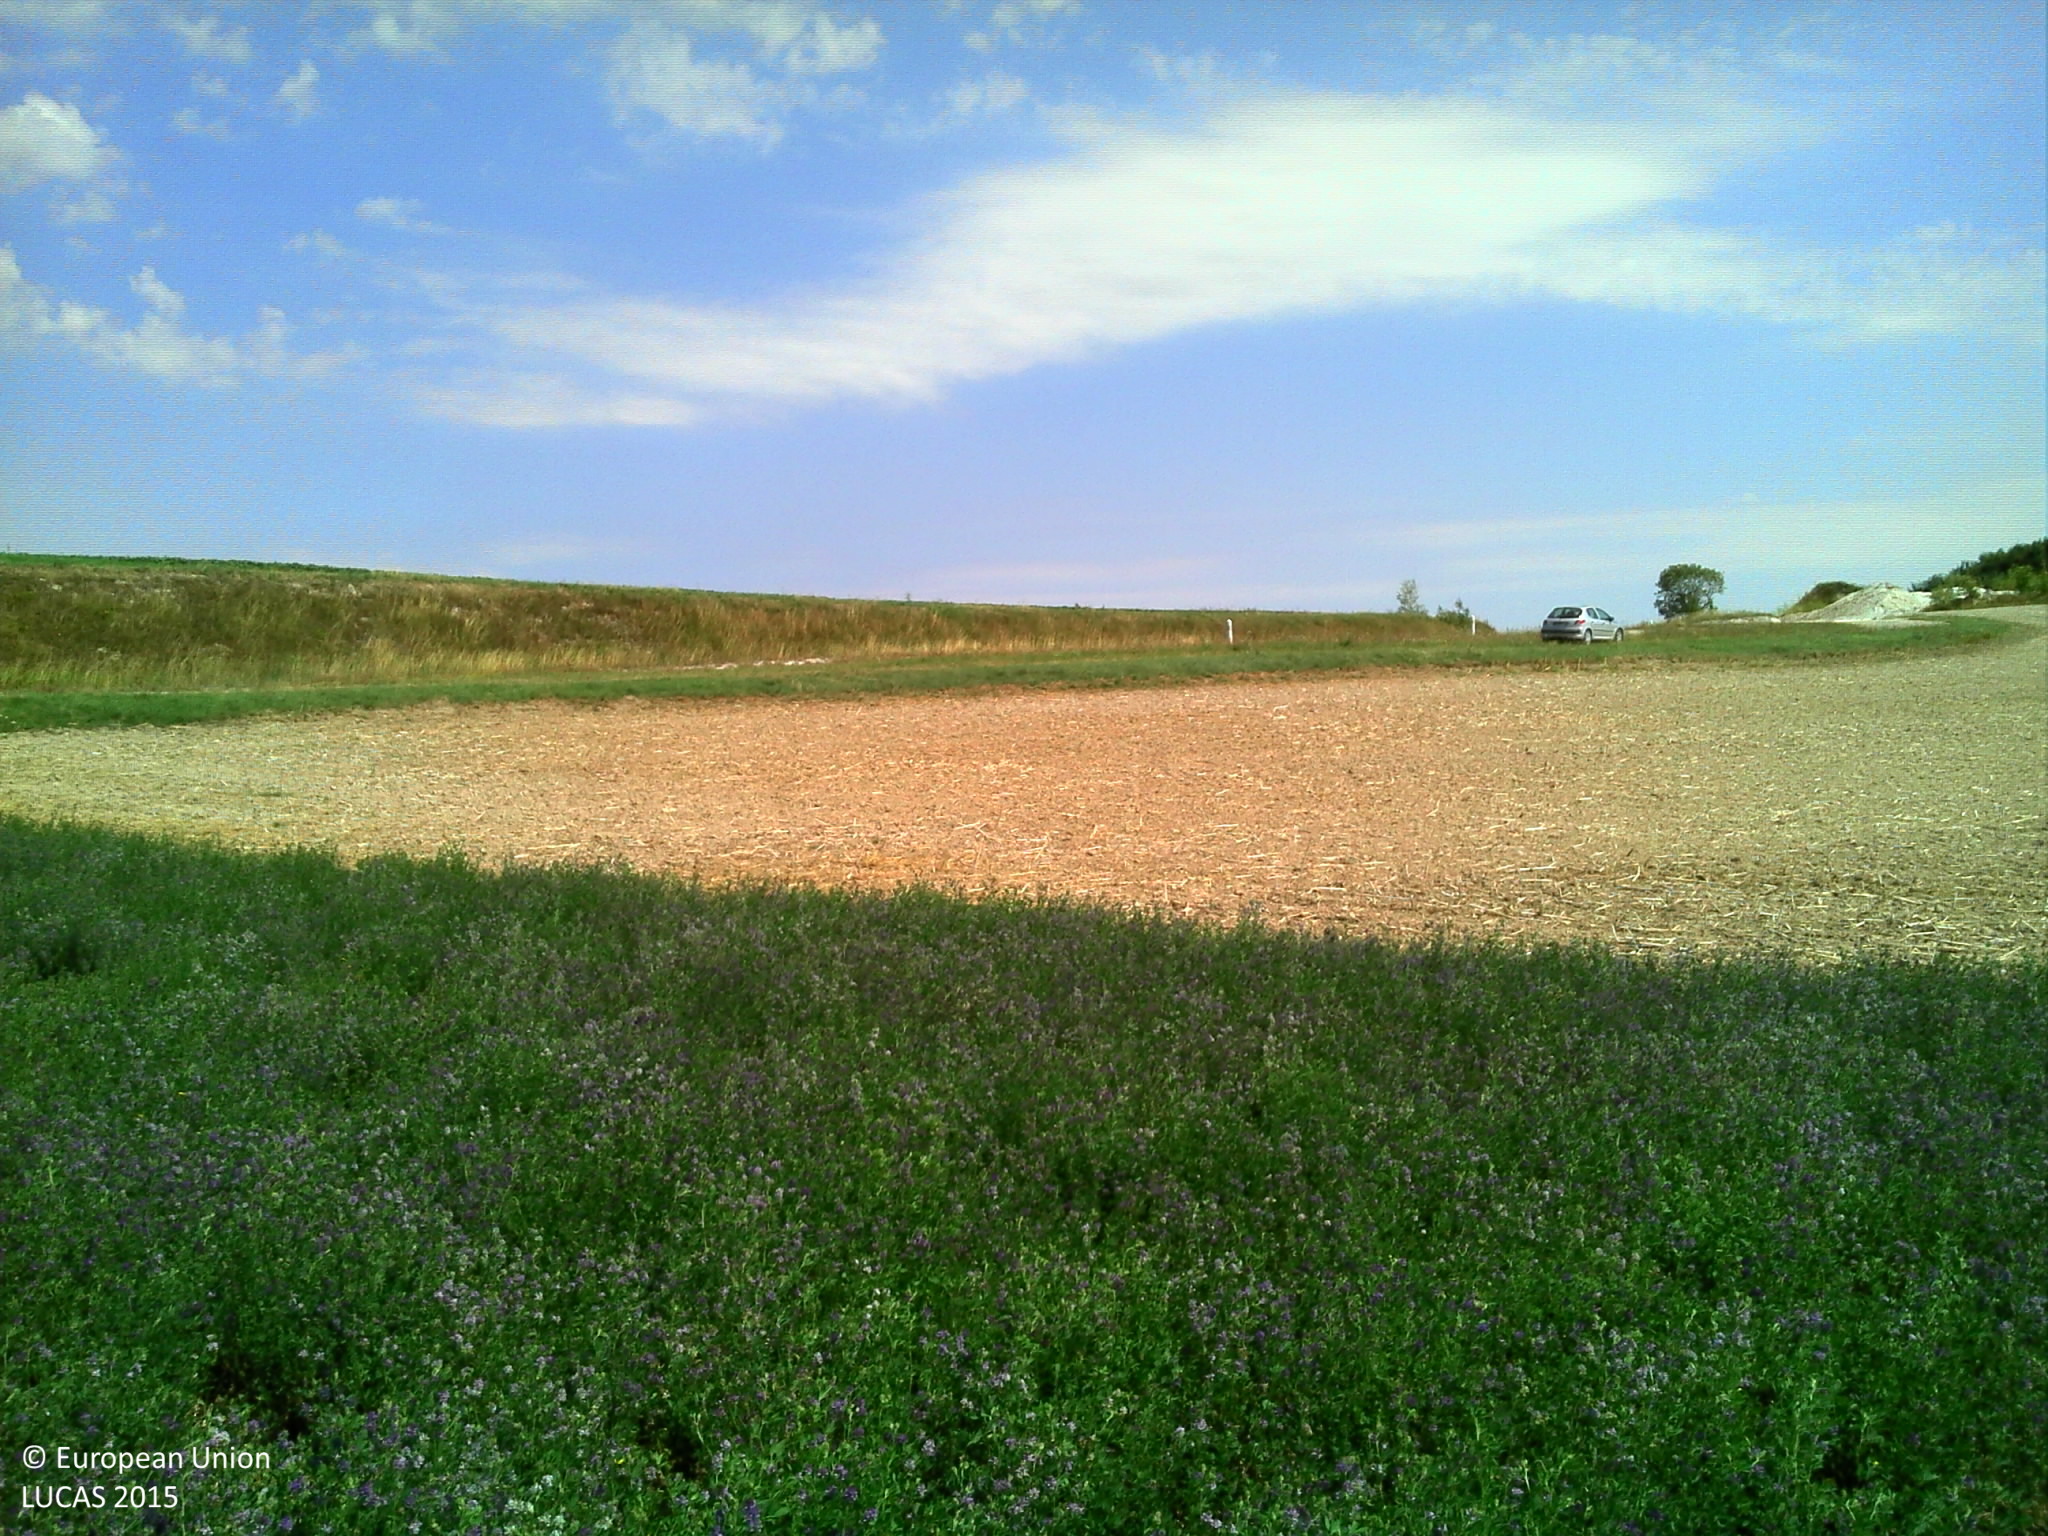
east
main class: Cropland
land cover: Lucerne
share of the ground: > 75 %
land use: Agriculture (excluding fallow land and kitchen gardens)
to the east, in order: Lucerne; Rape and turnip rape; Grass margins; Tracks; Grassland without tree/shrub cover; Grass margins; Paved roads, cycling and walking lanes; Grass margins; Ditches and canals; Grassland without tree/shrub cover; Sugar beet; Grass margins; Tracks; Grass margins; Other bare soil
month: August
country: FR
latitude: 49.0991
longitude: 4.2022
